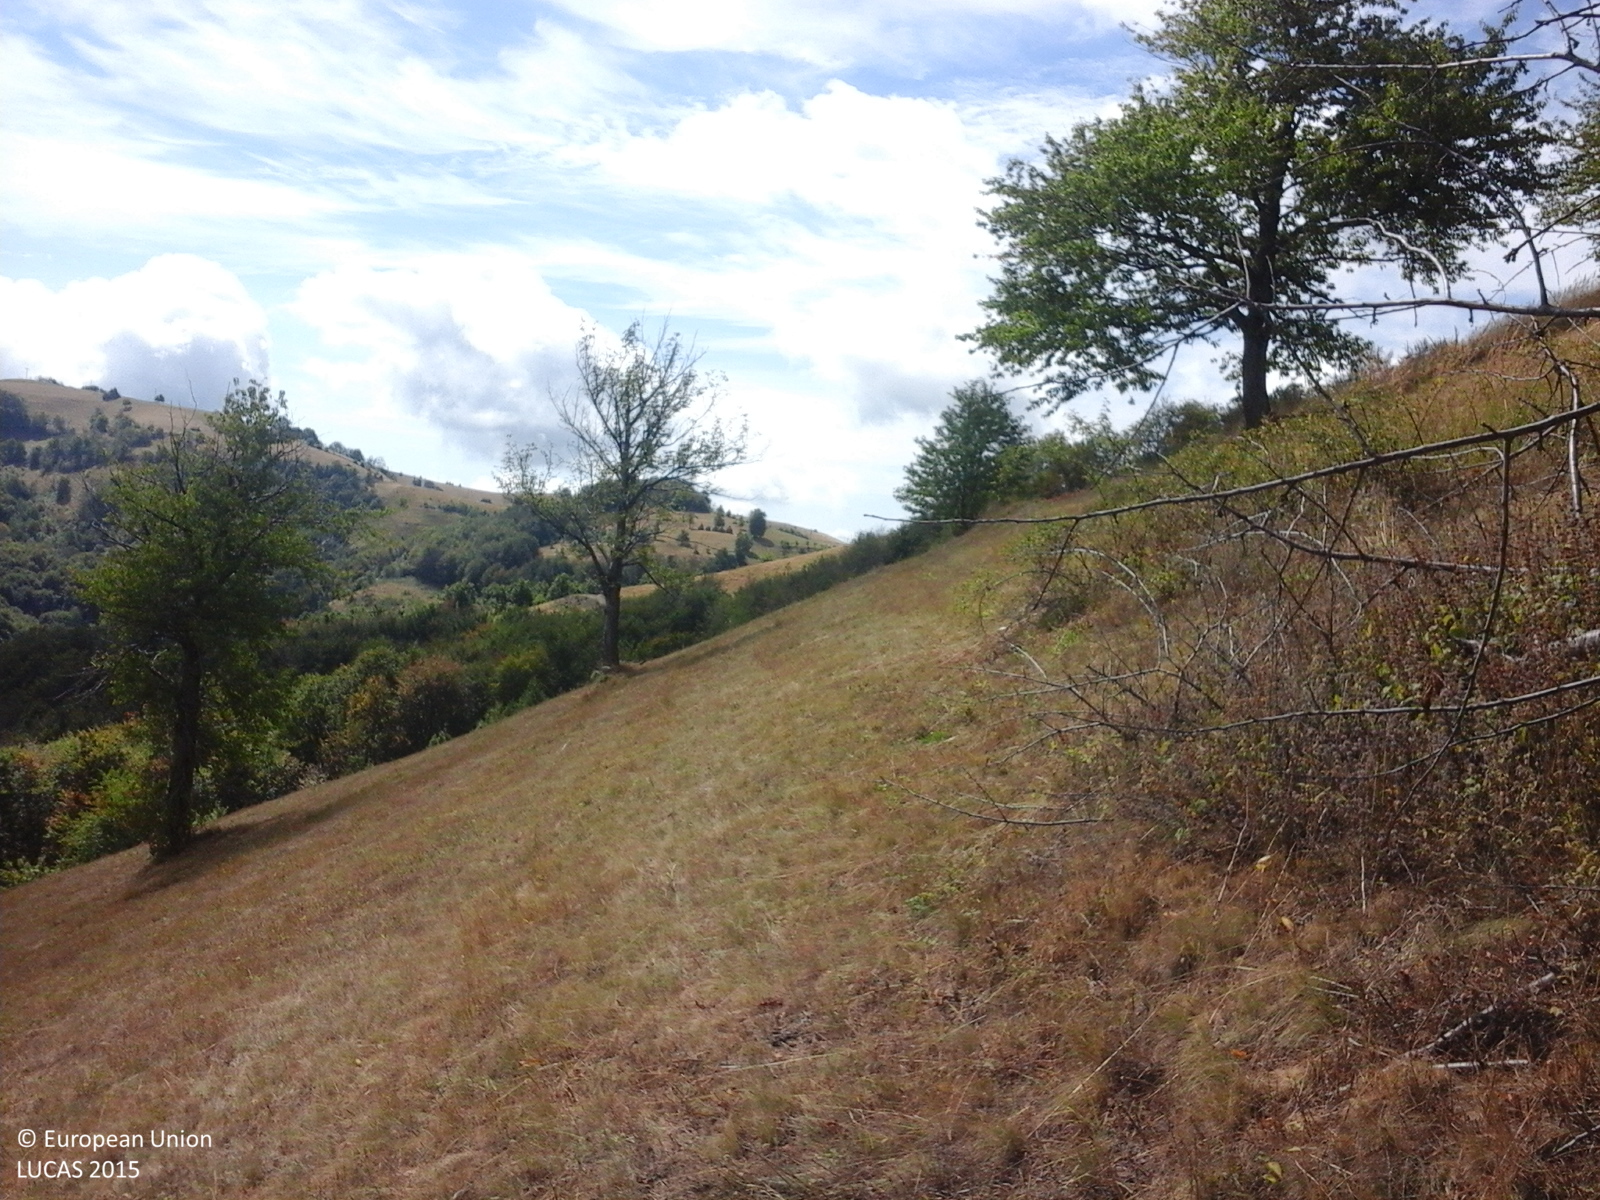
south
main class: Grassland
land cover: Grassland with sparse tree/shrub cover
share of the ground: > 75 %
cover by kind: herbaceous plants 85 %, shrubs 10 %, broadleaved forest trees 5 %
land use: Agriculture (excluding fallow land and kitchen gardens)
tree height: < 5 m
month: August
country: RO
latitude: 44.7950
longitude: 21.8768
